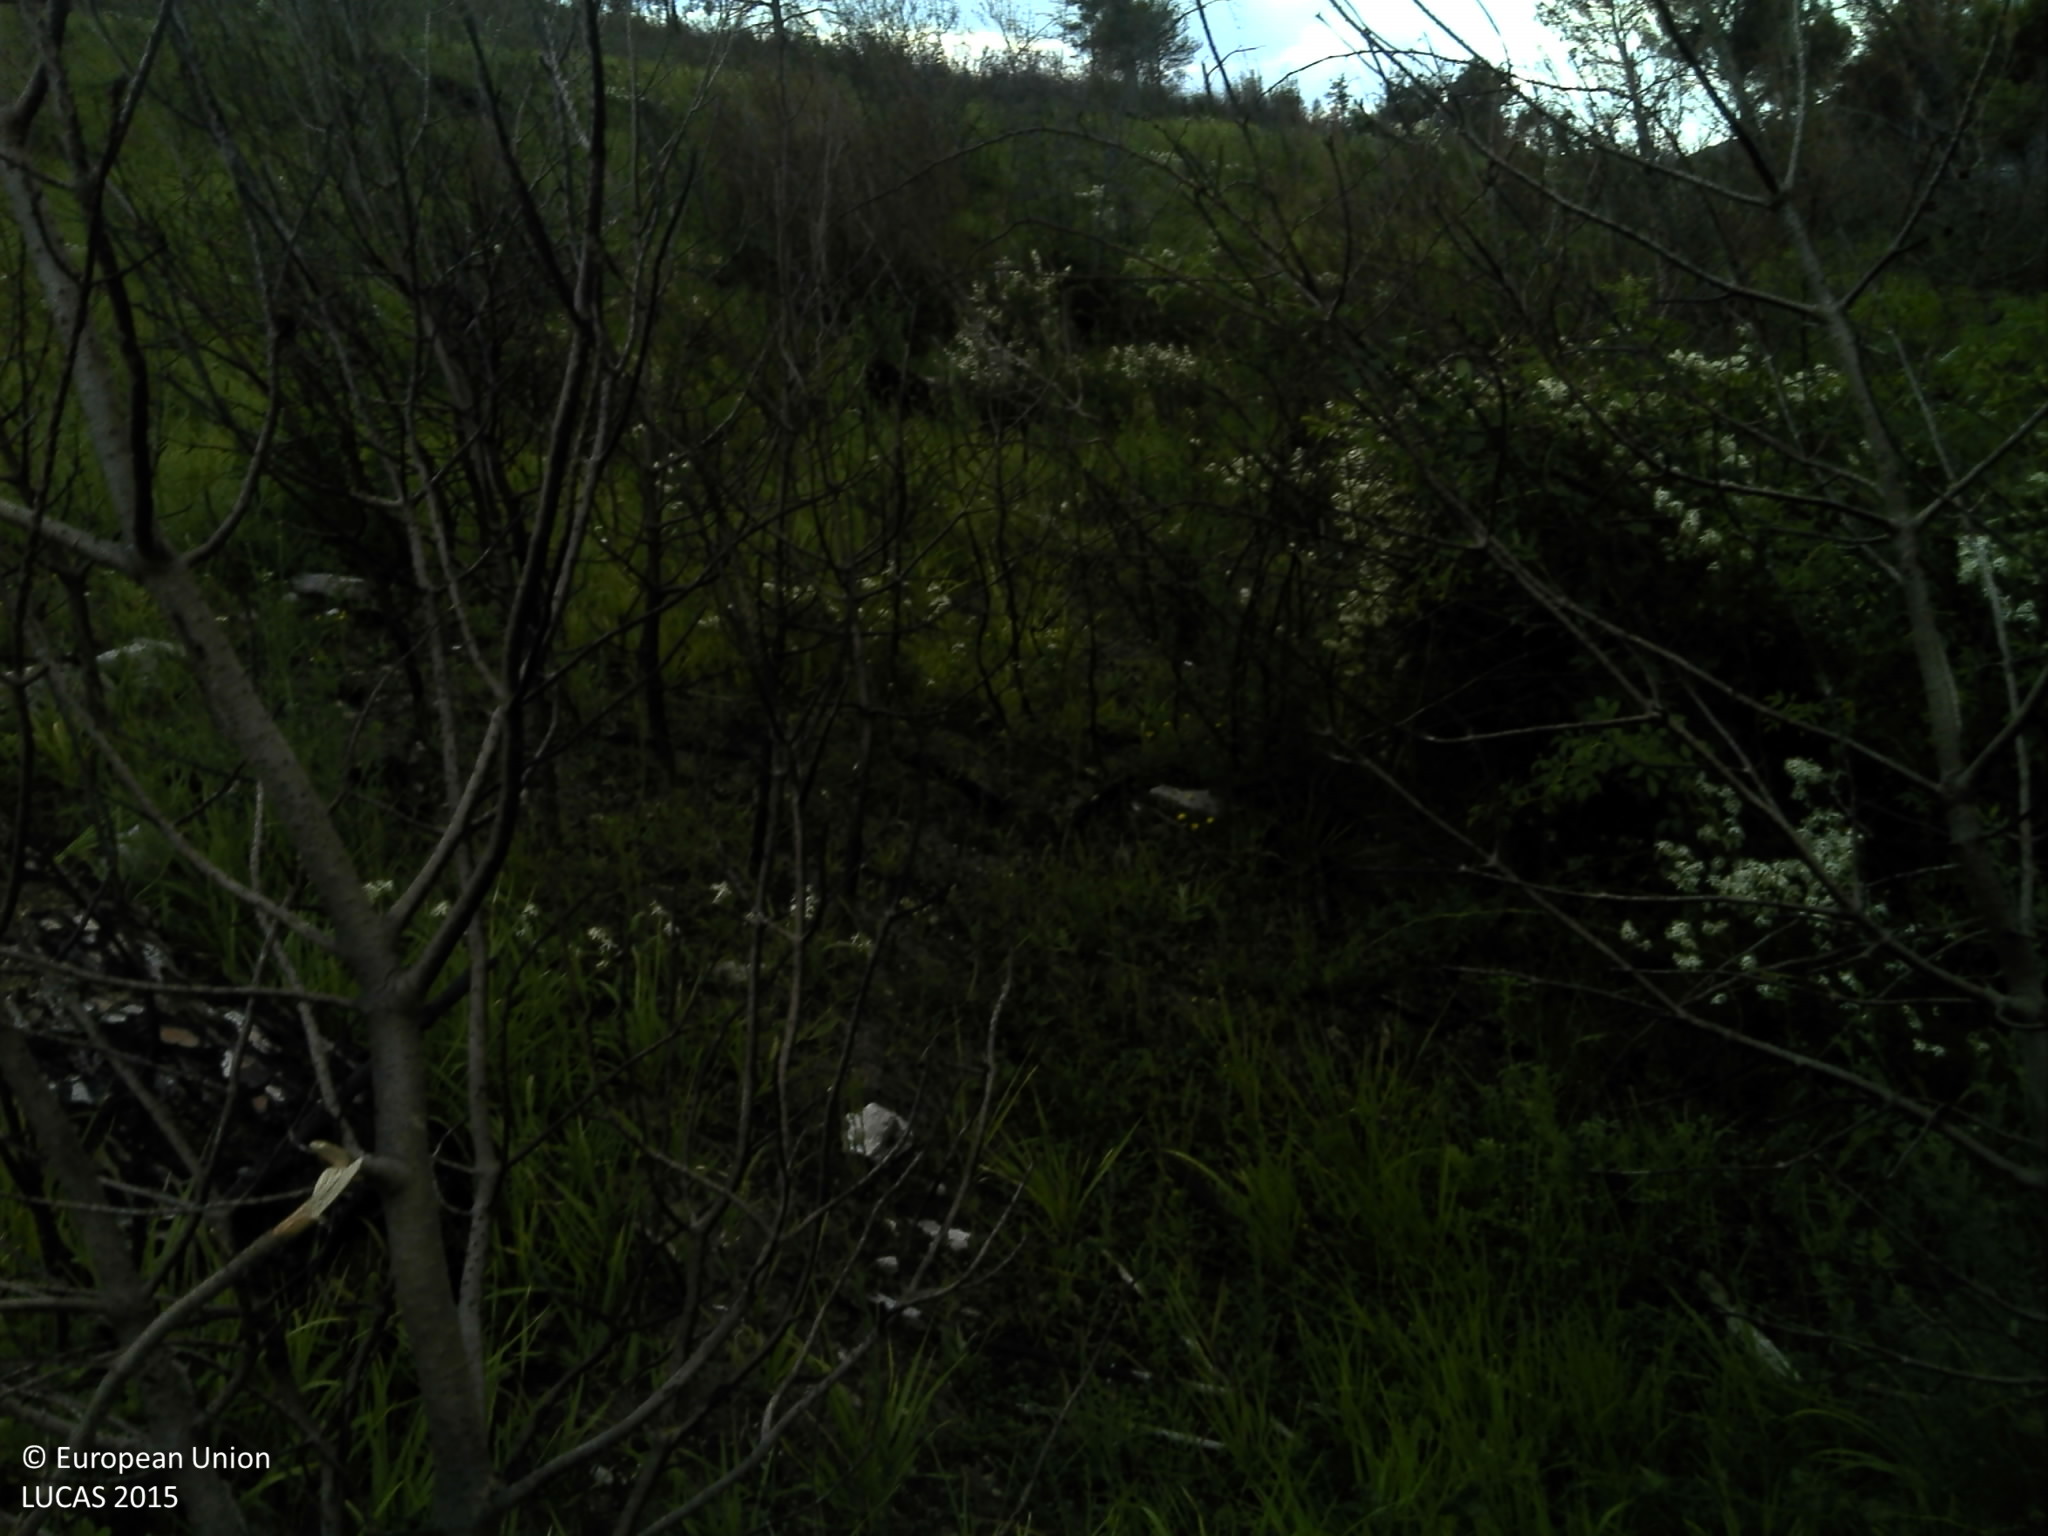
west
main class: Grassland
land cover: Spontaneously vegetated surfaces
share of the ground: > 75 %
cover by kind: herbaceous plants 80 %, shrubs 5 %, lichens and mosses 5 %, consolidated bare surface 5 %, unconsolidated bare surface 5 %
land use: Semi-natural and natural areas not in use
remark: Burnt area
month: June
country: HR
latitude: 43.5487
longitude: 16.5140
